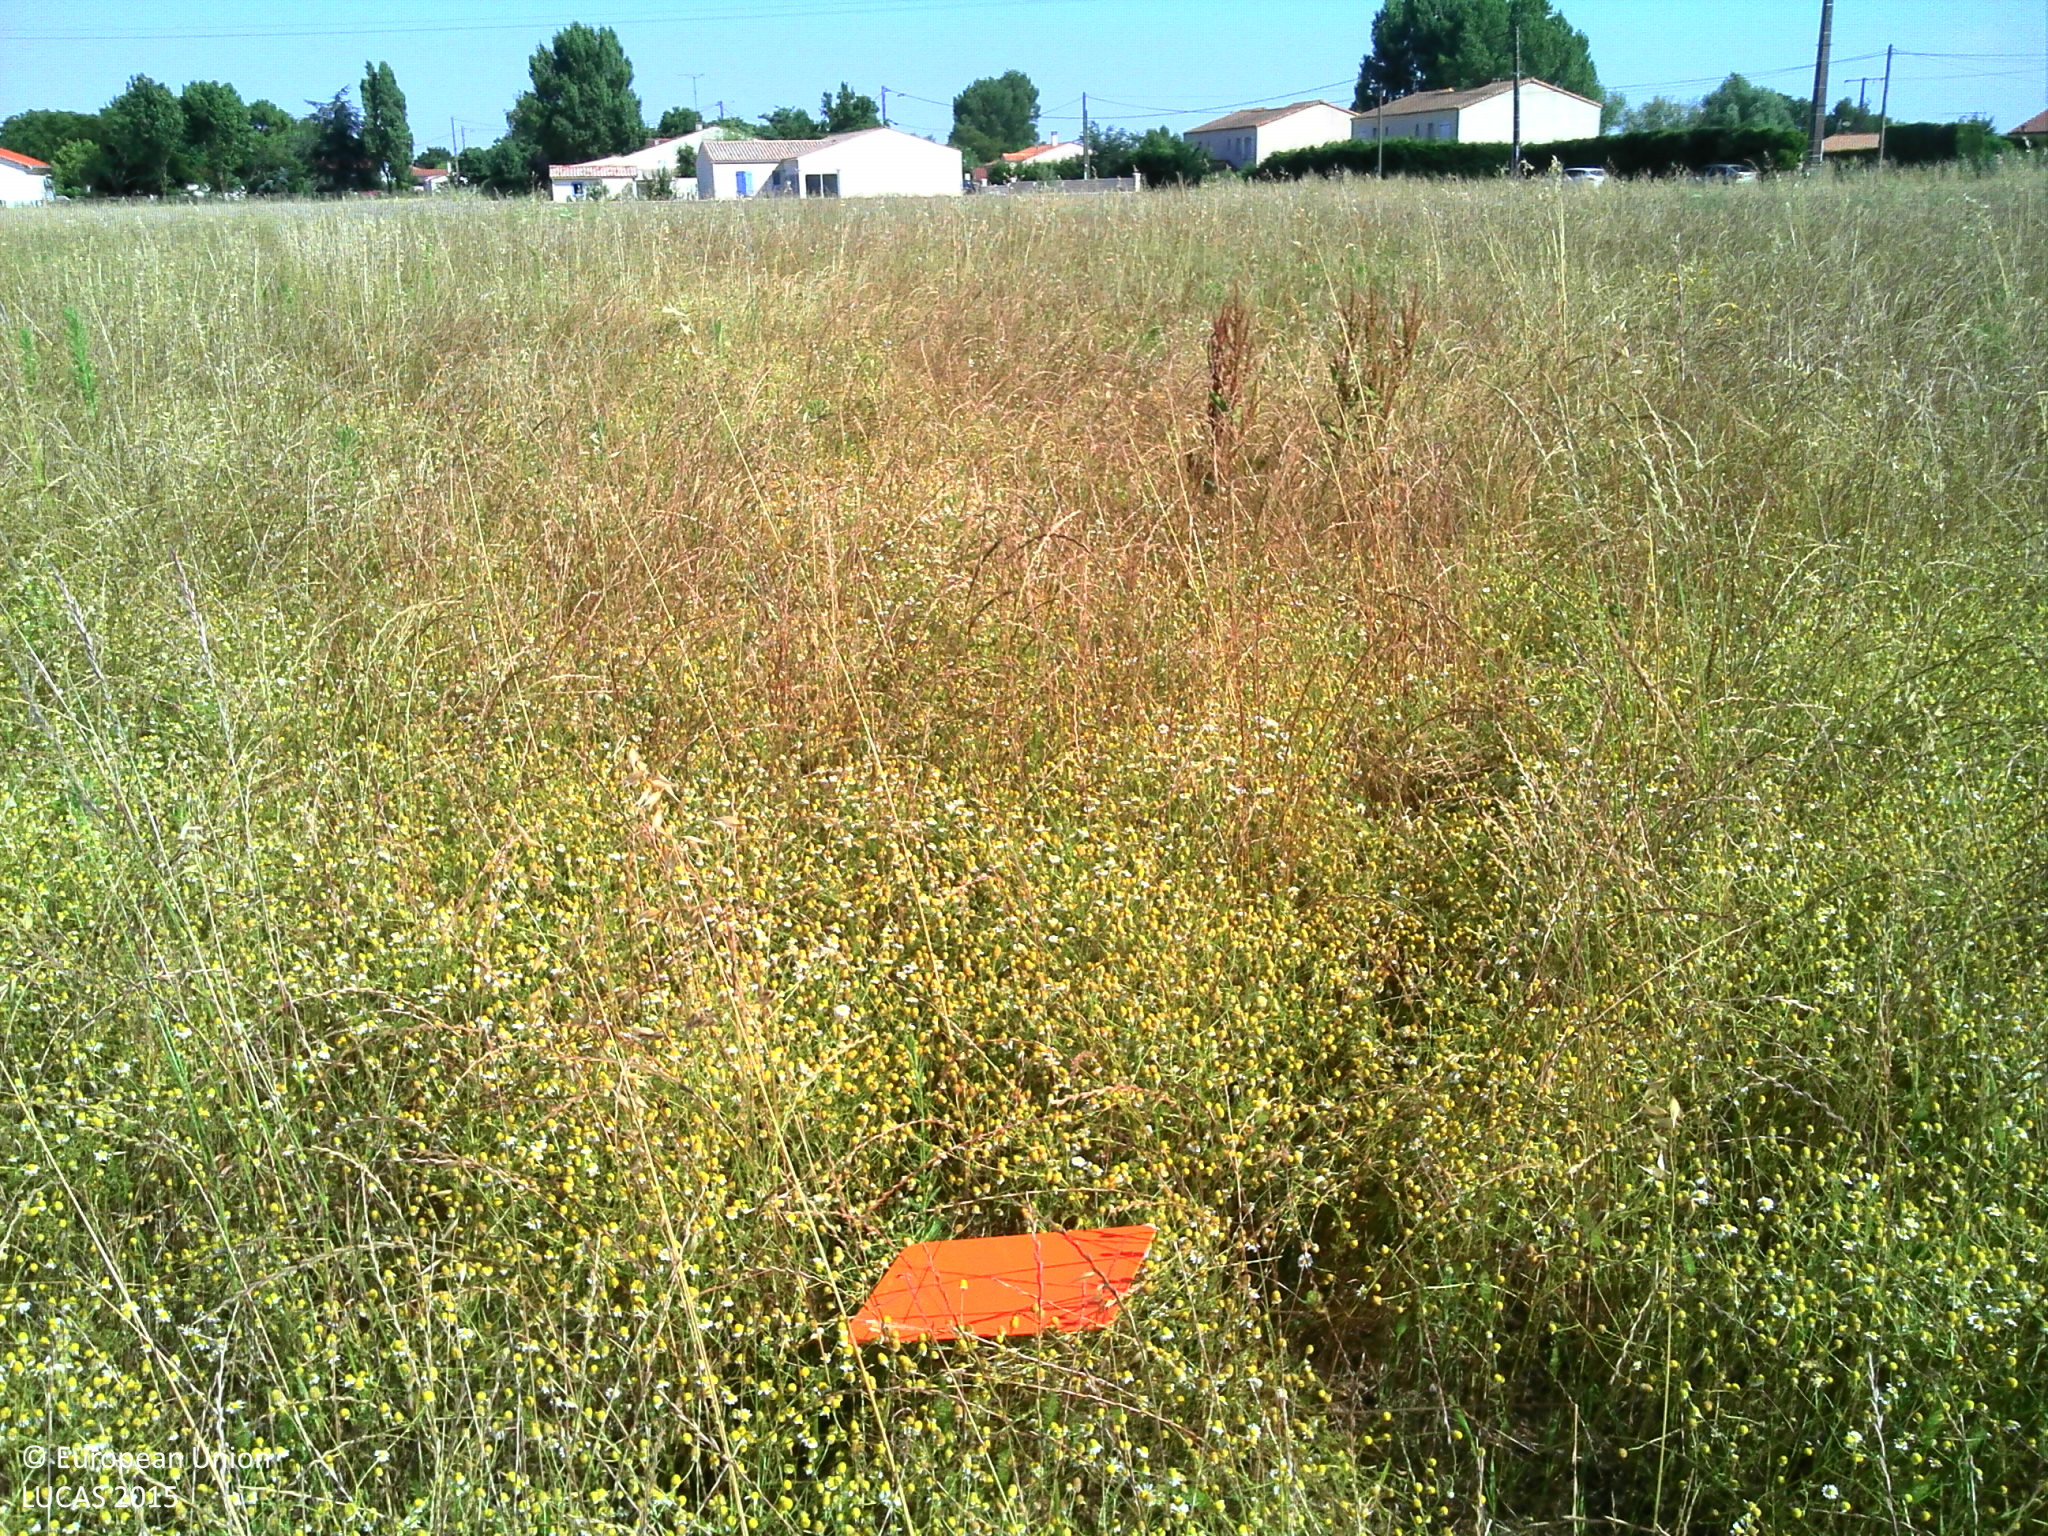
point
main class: Grassland
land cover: Grassland without tree/shrub cover
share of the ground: > 75 %
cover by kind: herbaceous plants 100 %
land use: Agriculture (excluding fallow land and kitchen gardens)
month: June
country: FR
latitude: 45.7314
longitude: -0.9632
